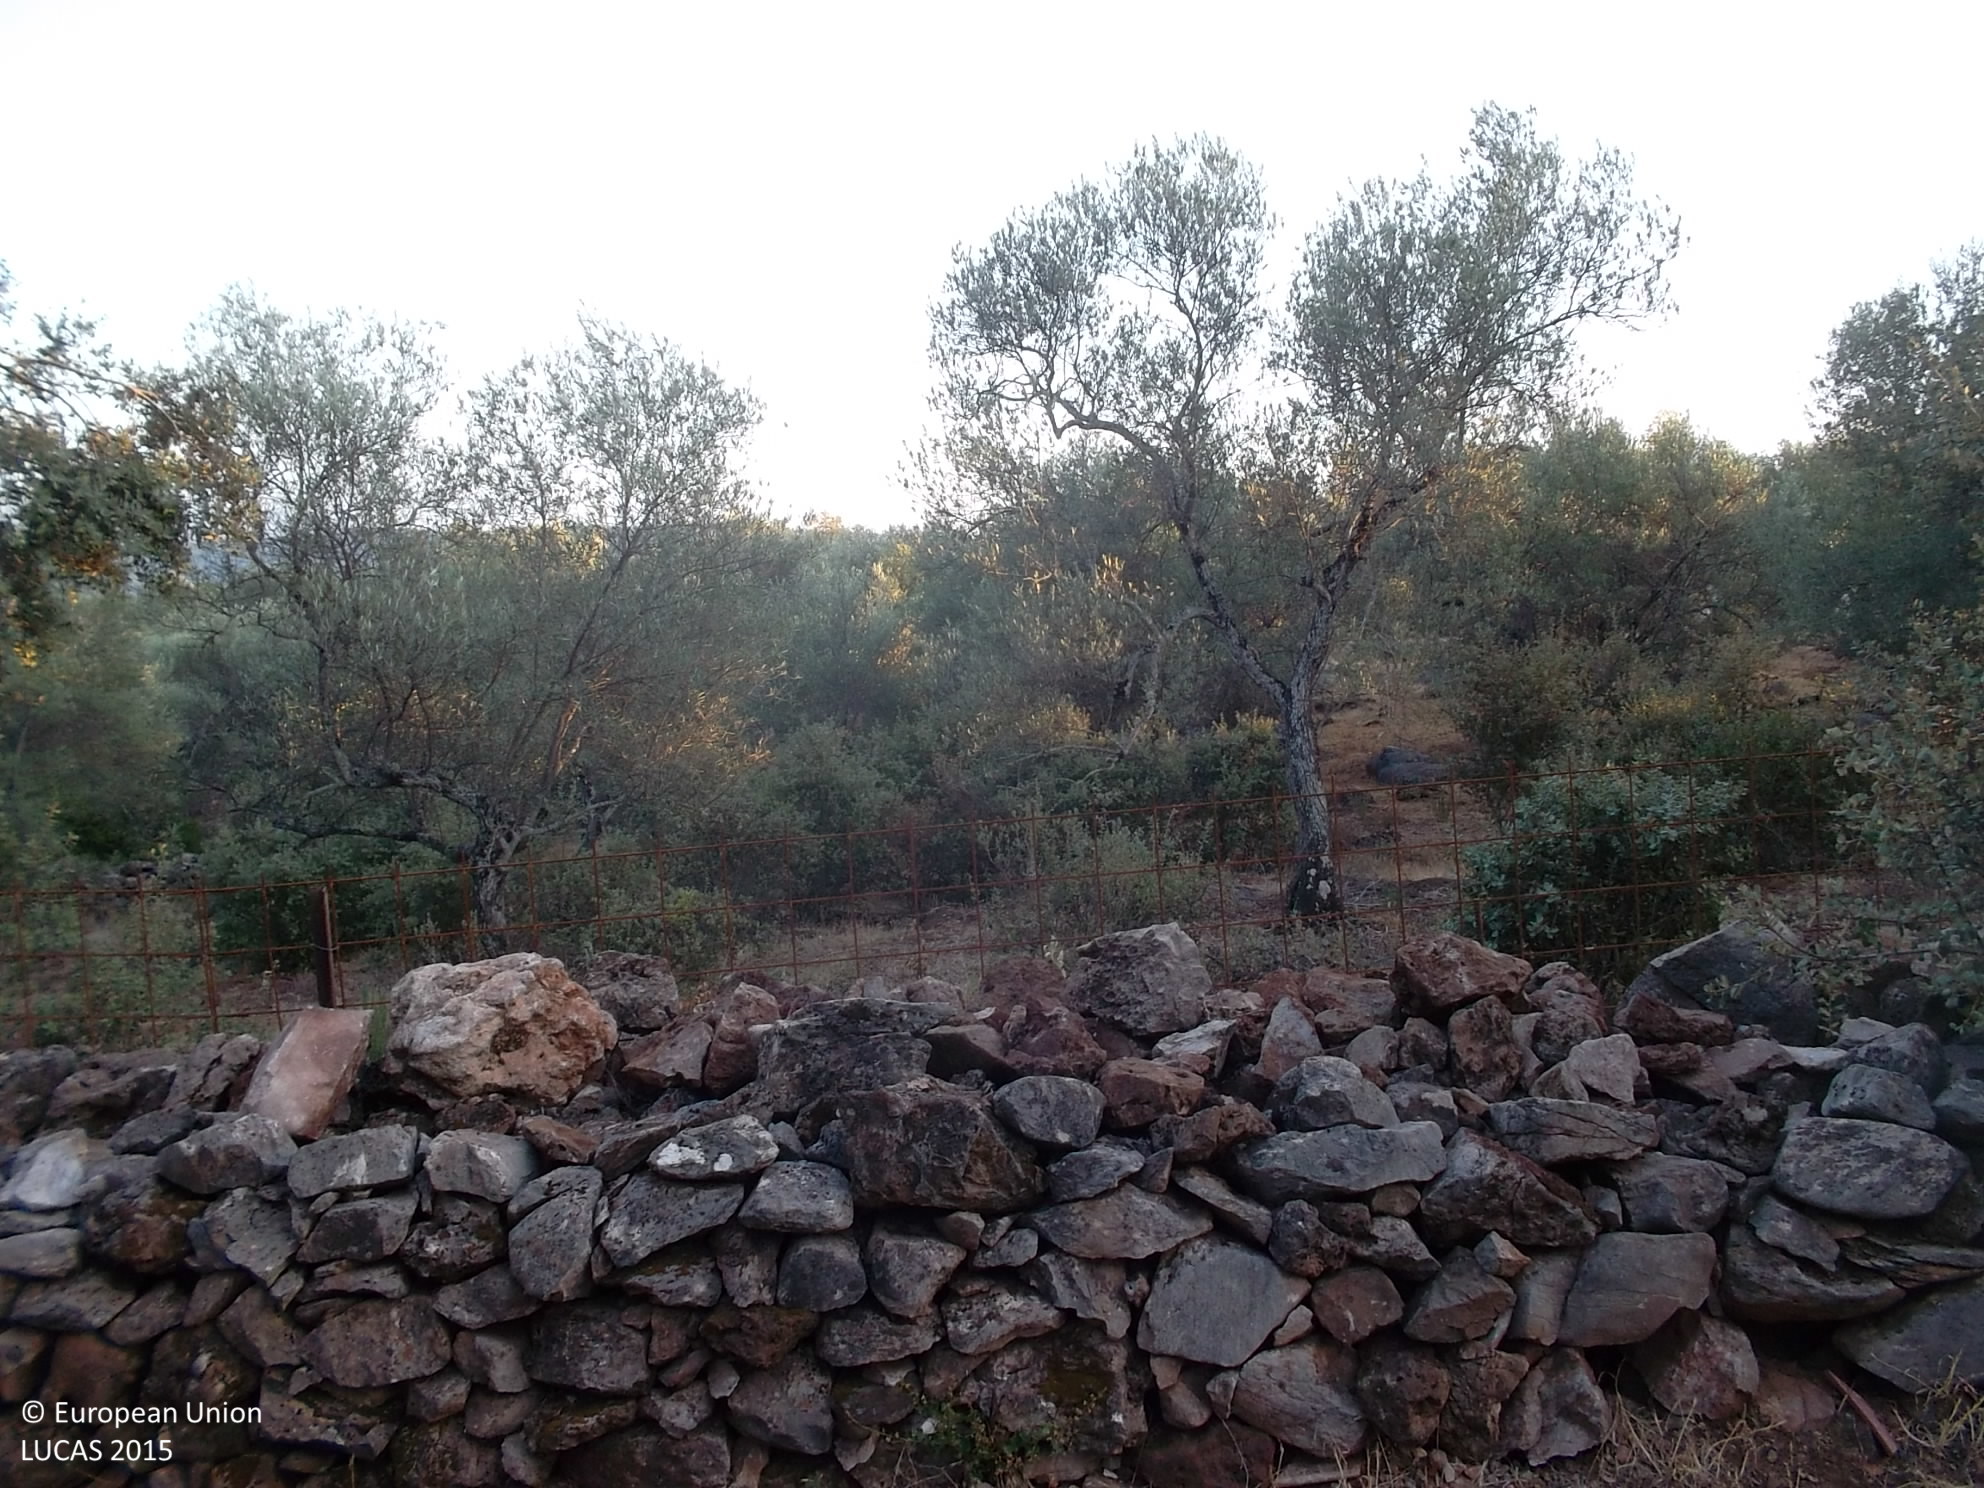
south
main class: Cropland
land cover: Olive groves
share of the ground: 25 - 50 %
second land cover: Shrubland without tree cover
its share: > 75 %
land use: Abandoned areas
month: September
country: ES
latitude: 38.0209
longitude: -6.5514
